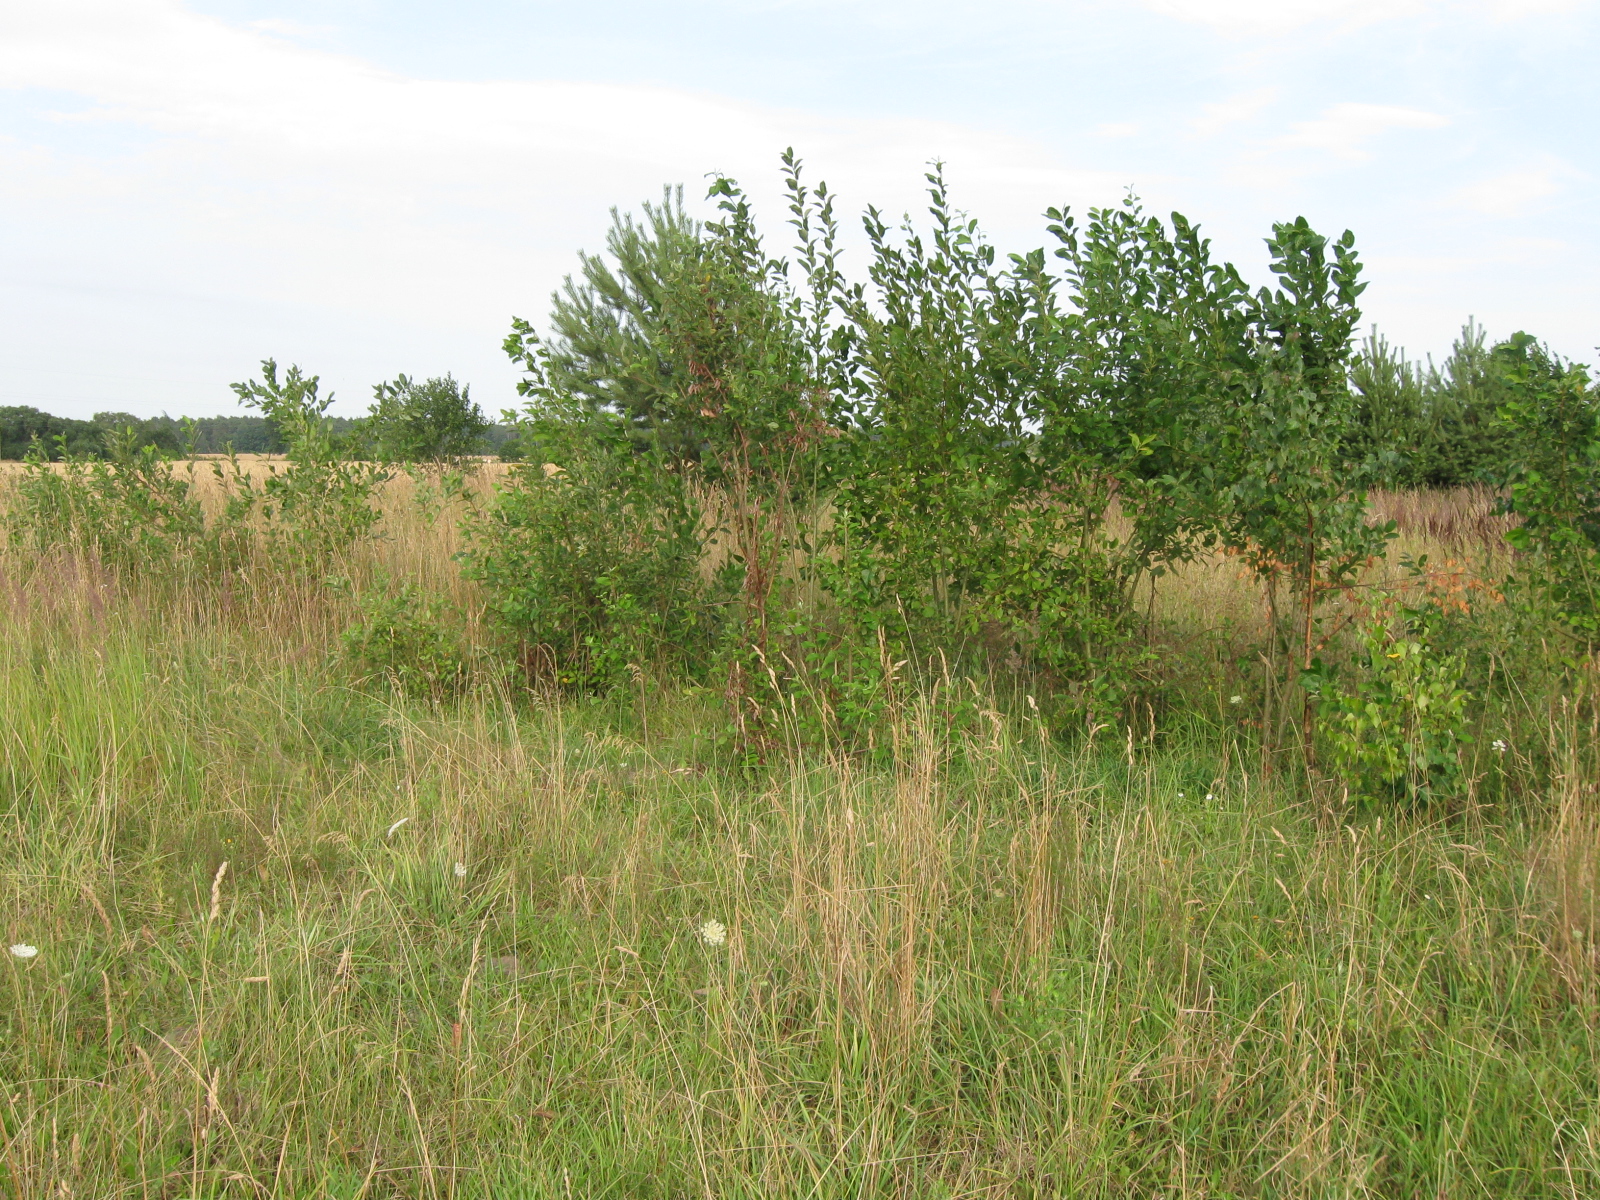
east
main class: Grassland
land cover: Grassland with sparse tree/shrub cover
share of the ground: > 75 %
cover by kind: herbaceous plants 90 %, broadleaved forest trees 5 %, shrubs 5 %
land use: Agriculture (excluding fallow land and kitchen gardens)
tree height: < 5 m
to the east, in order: Grassland with sparse tree/shrub cover; Abandoned hedges; Grassland with sparse tree/shrub cover; Common wheat
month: July
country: LT
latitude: 54.6864
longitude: 23.8160
